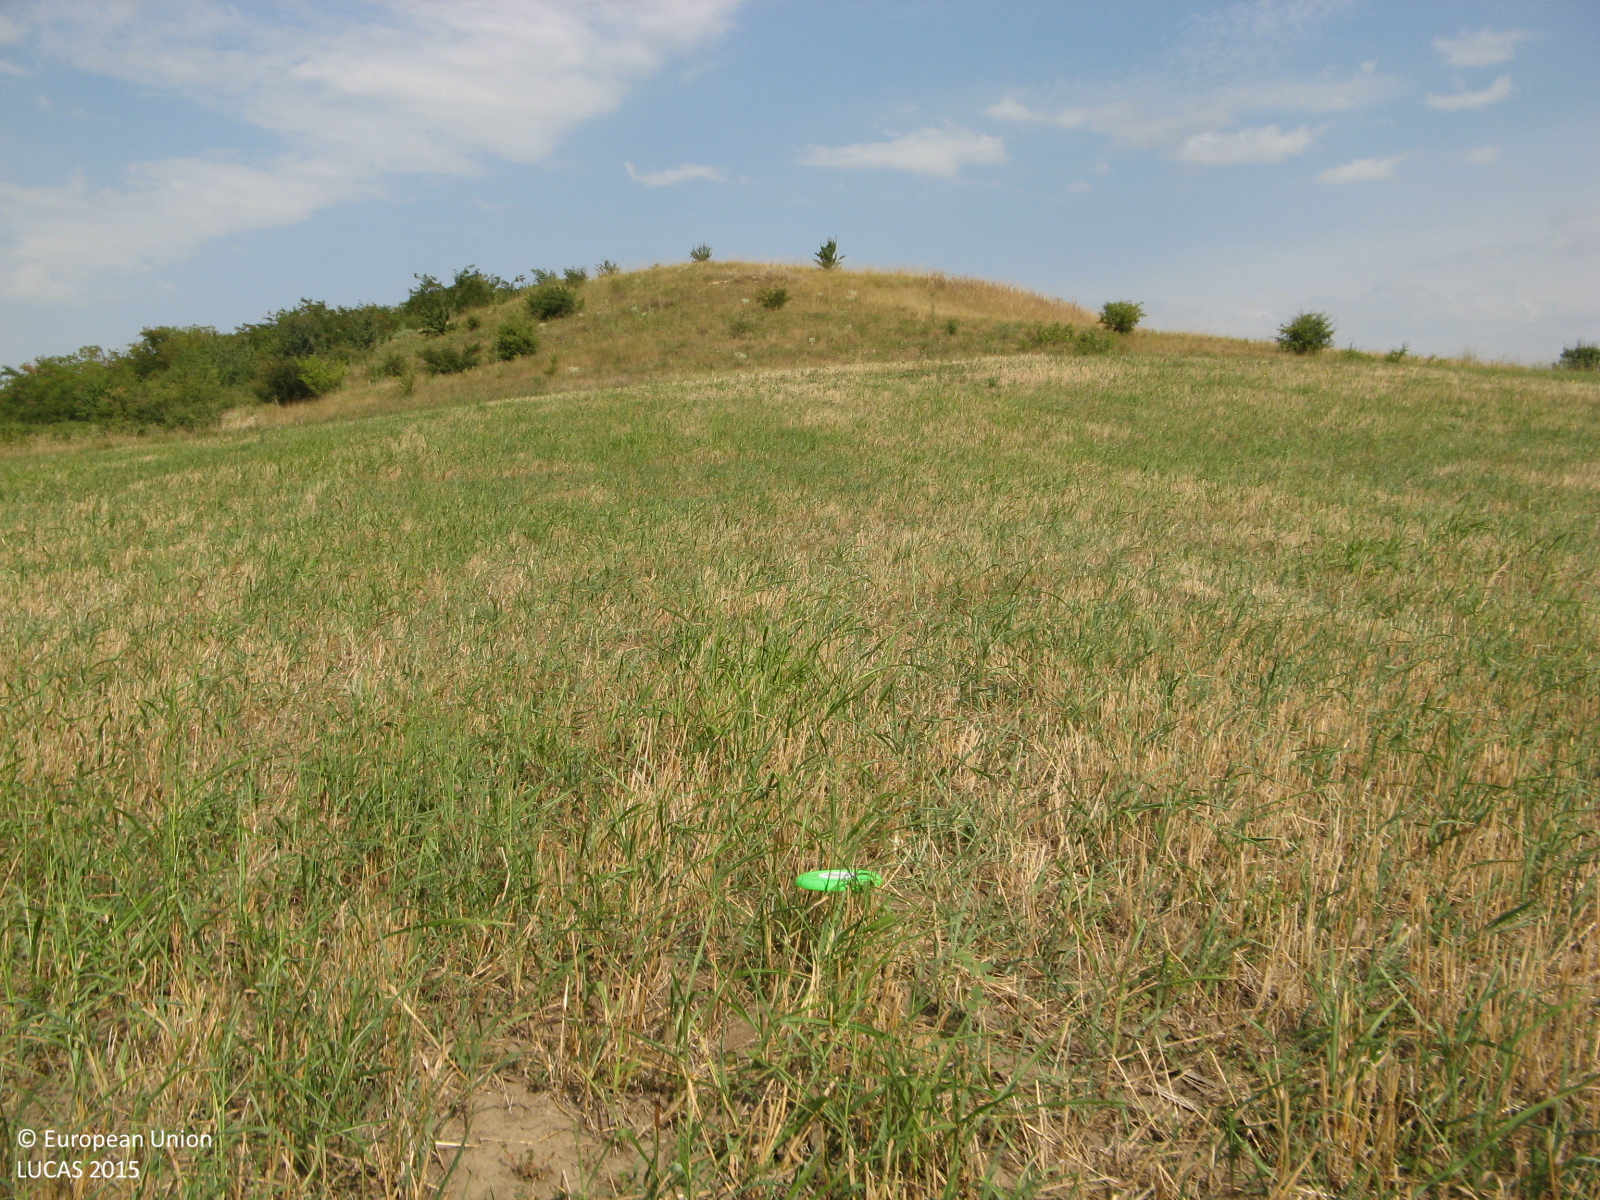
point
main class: Cropland
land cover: Common wheat
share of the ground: 50 - 75 %
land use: Agriculture (excluding fallow land and kitchen gardens)
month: August
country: BG
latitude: 43.4694
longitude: 25.2683
